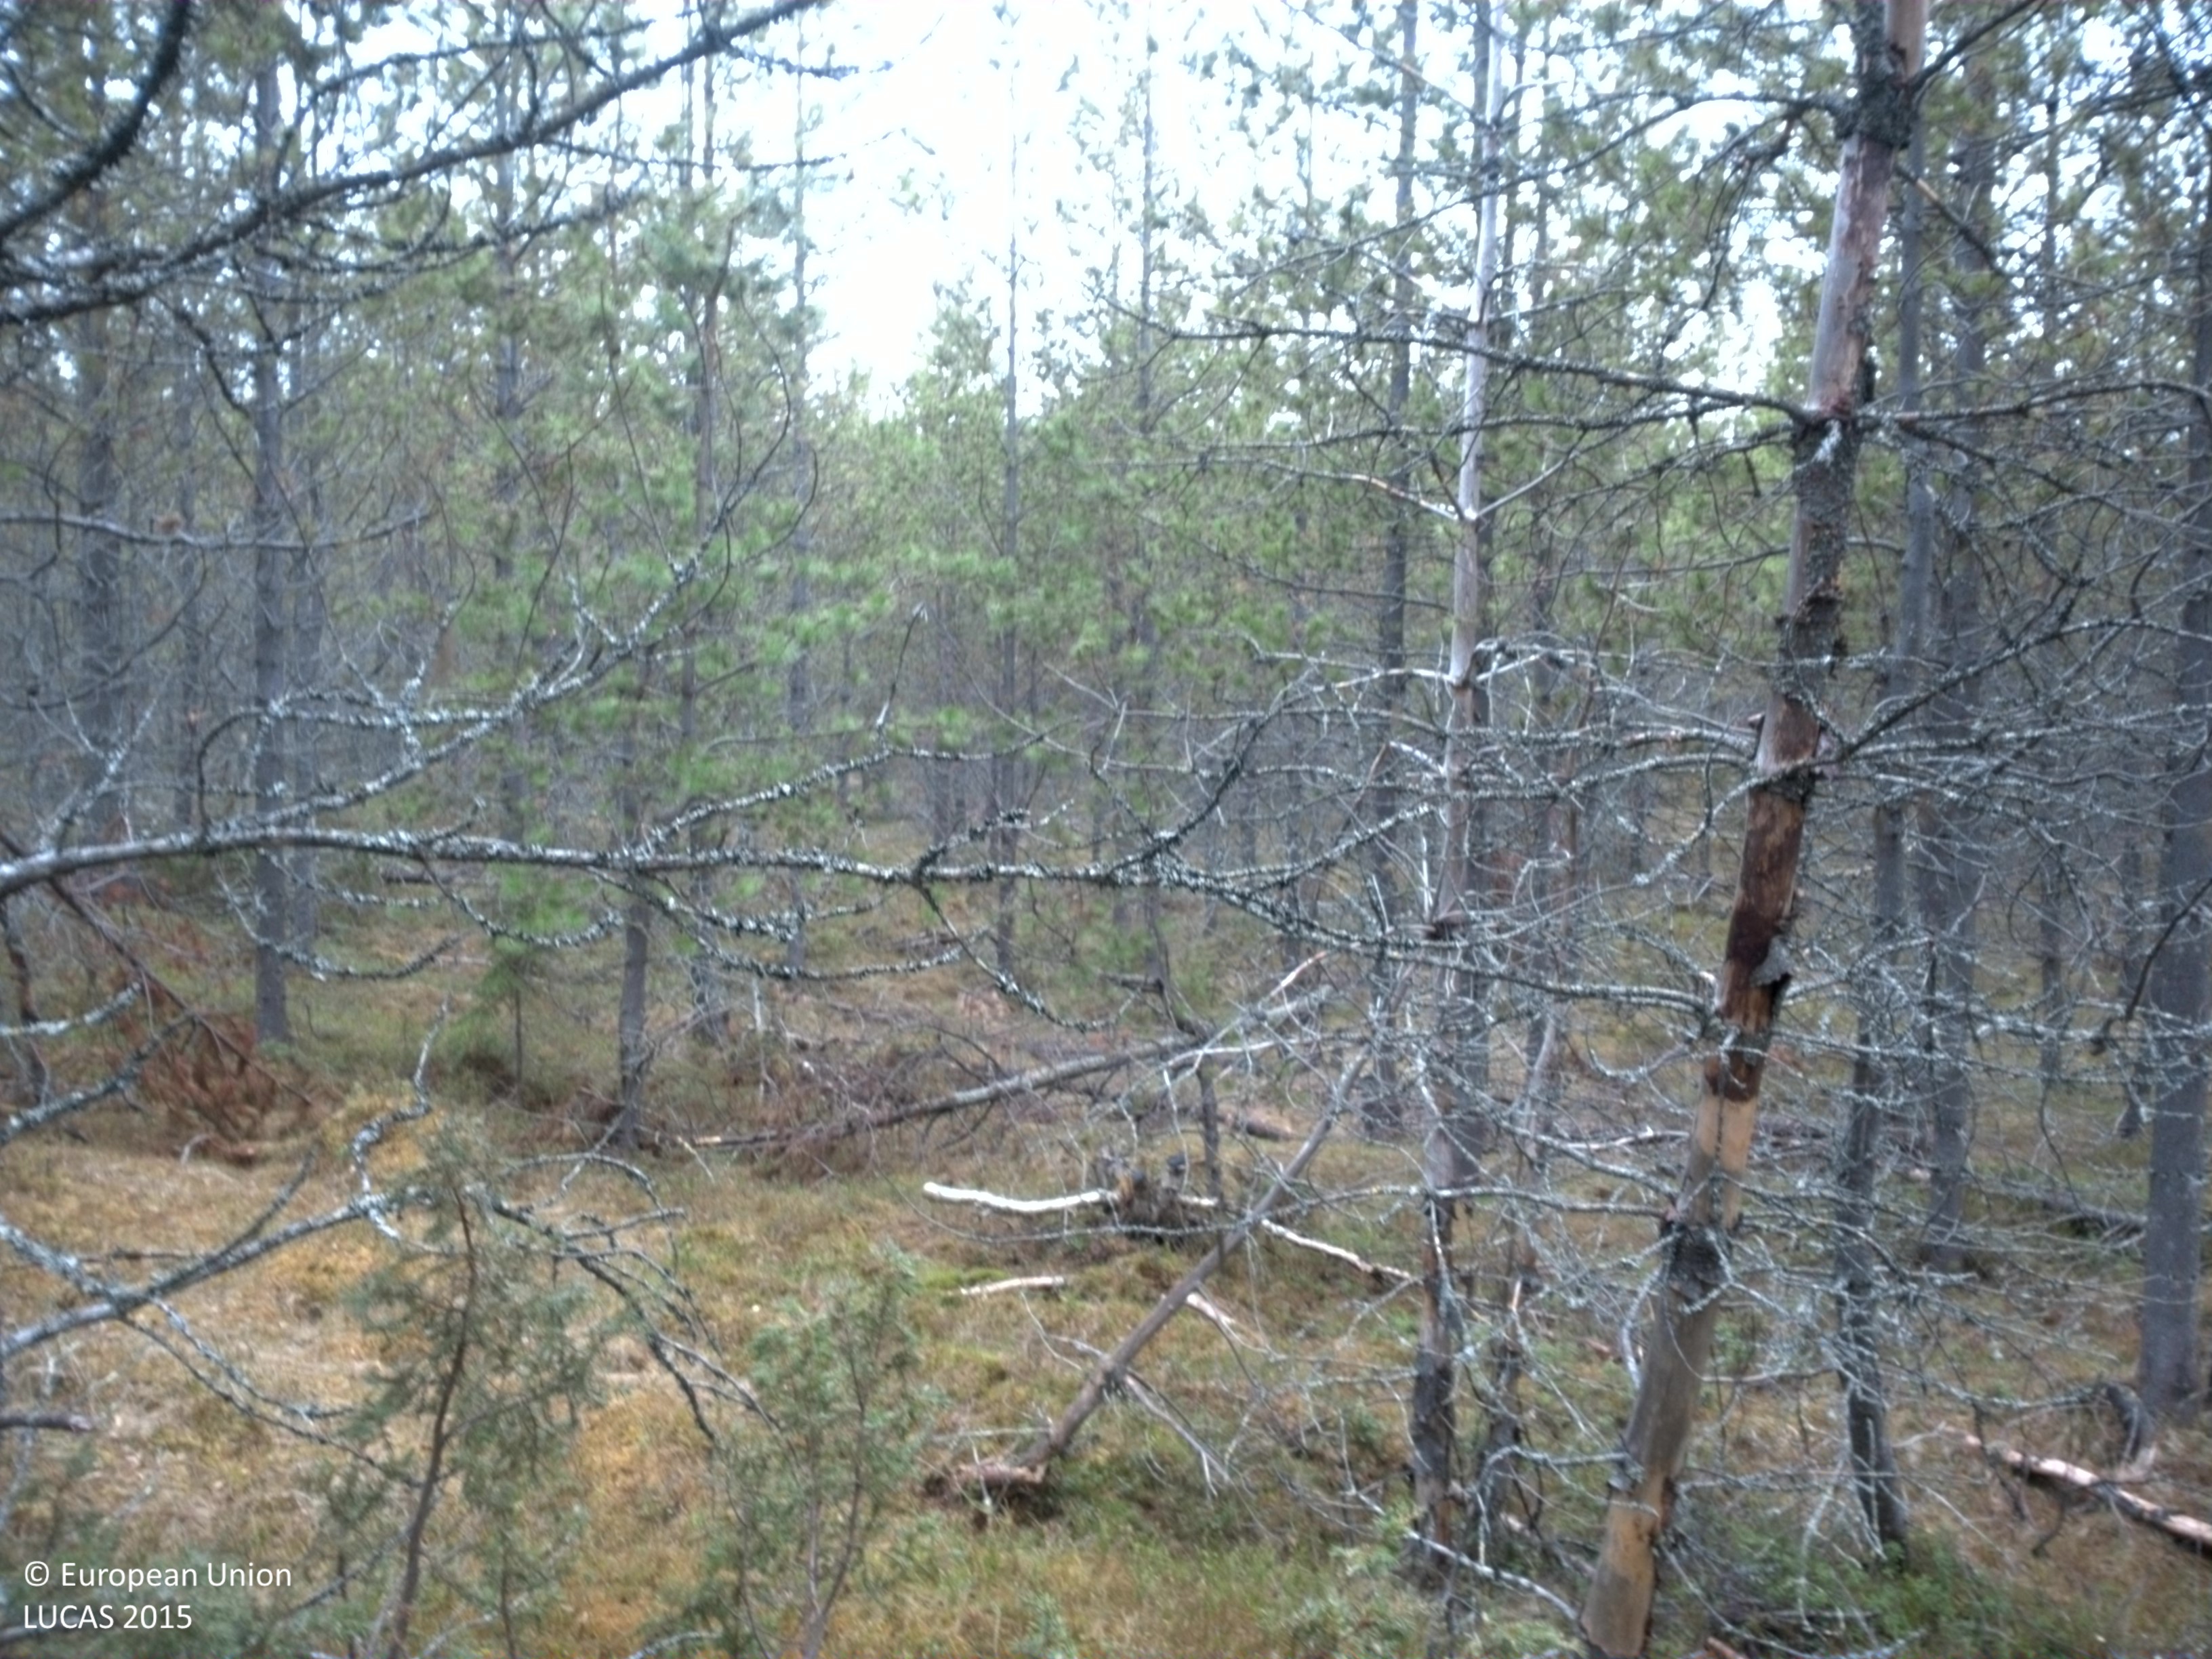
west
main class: Woodland
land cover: Pine dominated coniferous woodland
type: exotic forest
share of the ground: 25 - 50 %
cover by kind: coniferous forest trees 45 %, herbaceous plants 25 %, lichens and mosses 15 %, shrubs 10 %, broadleaved forest trees 5 %
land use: Forestry
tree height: > 5 m
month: June
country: SE
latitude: 64.3564
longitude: 18.0663
